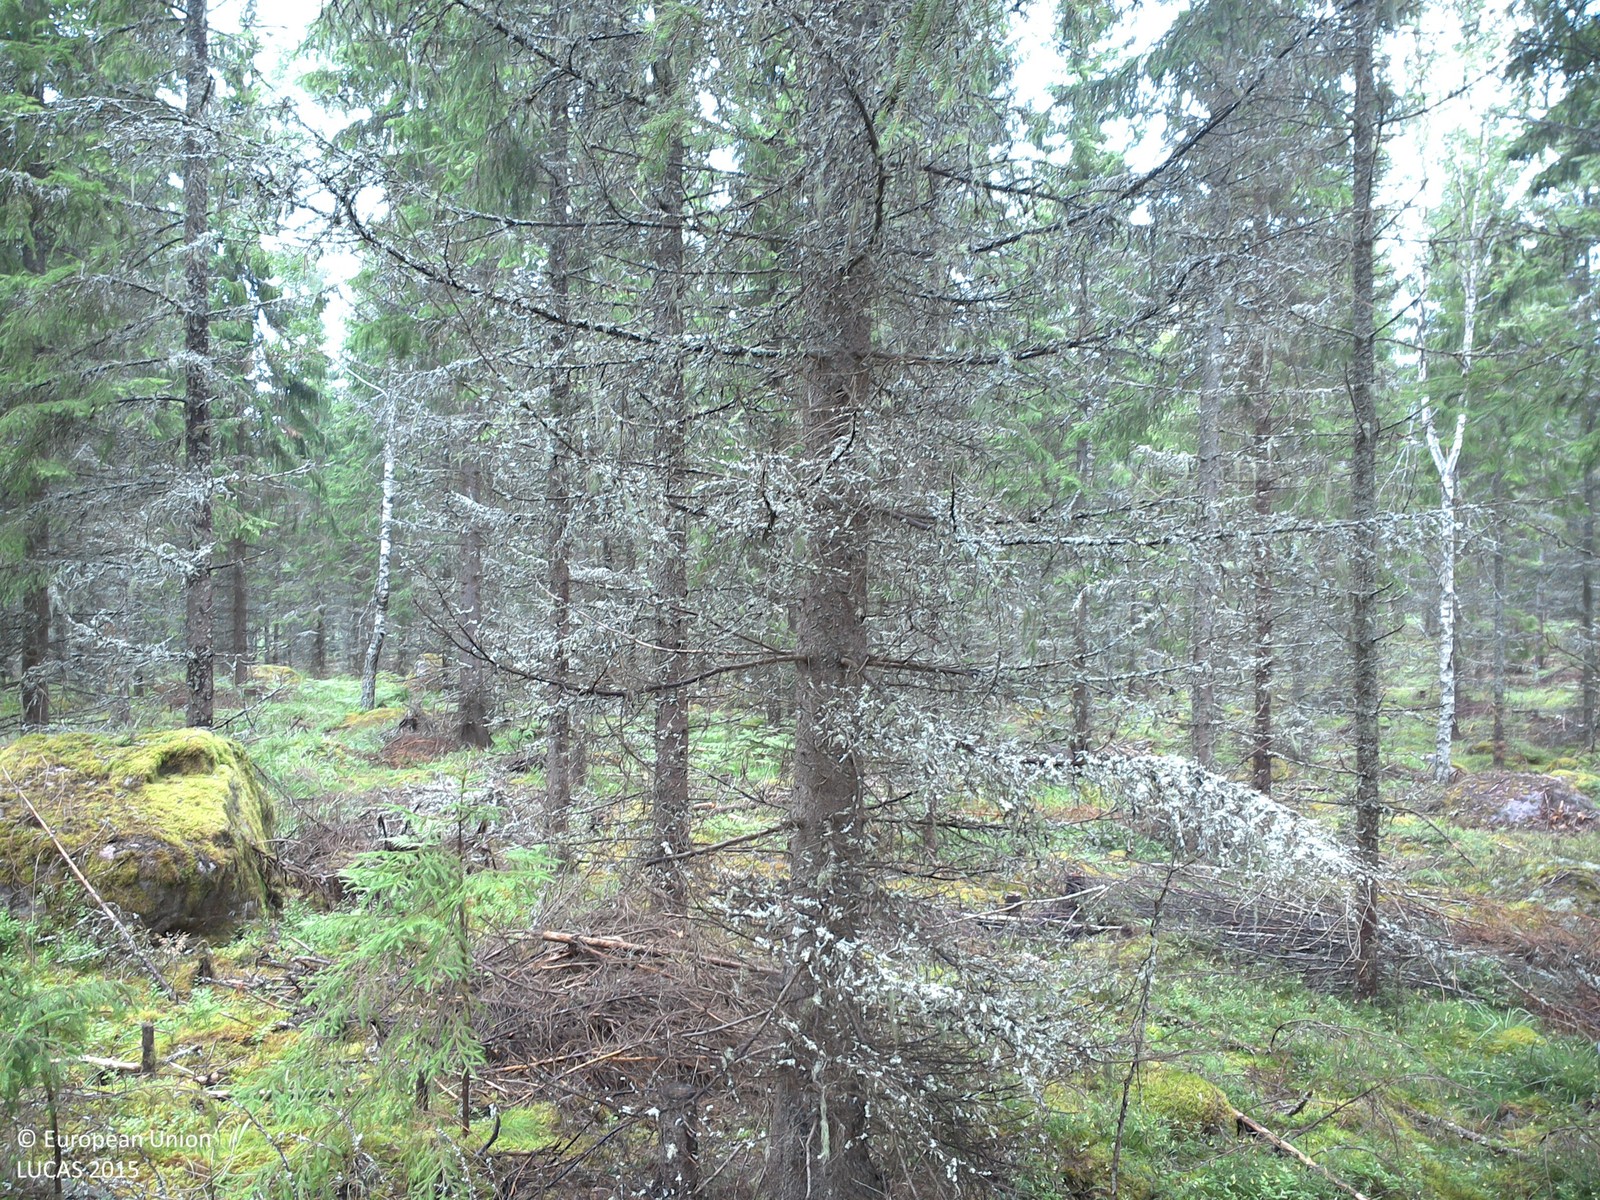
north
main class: Woodland
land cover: Spruce dominated coniferous woodland
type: boreal forest
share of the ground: 50 - 75 %
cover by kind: coniferous forest trees 55 %, lichens and mosses 30 %, herbaceous plants 15 %
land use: Forestry
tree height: > 5 m
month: August
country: SE
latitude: 58.2003
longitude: 15.4225
